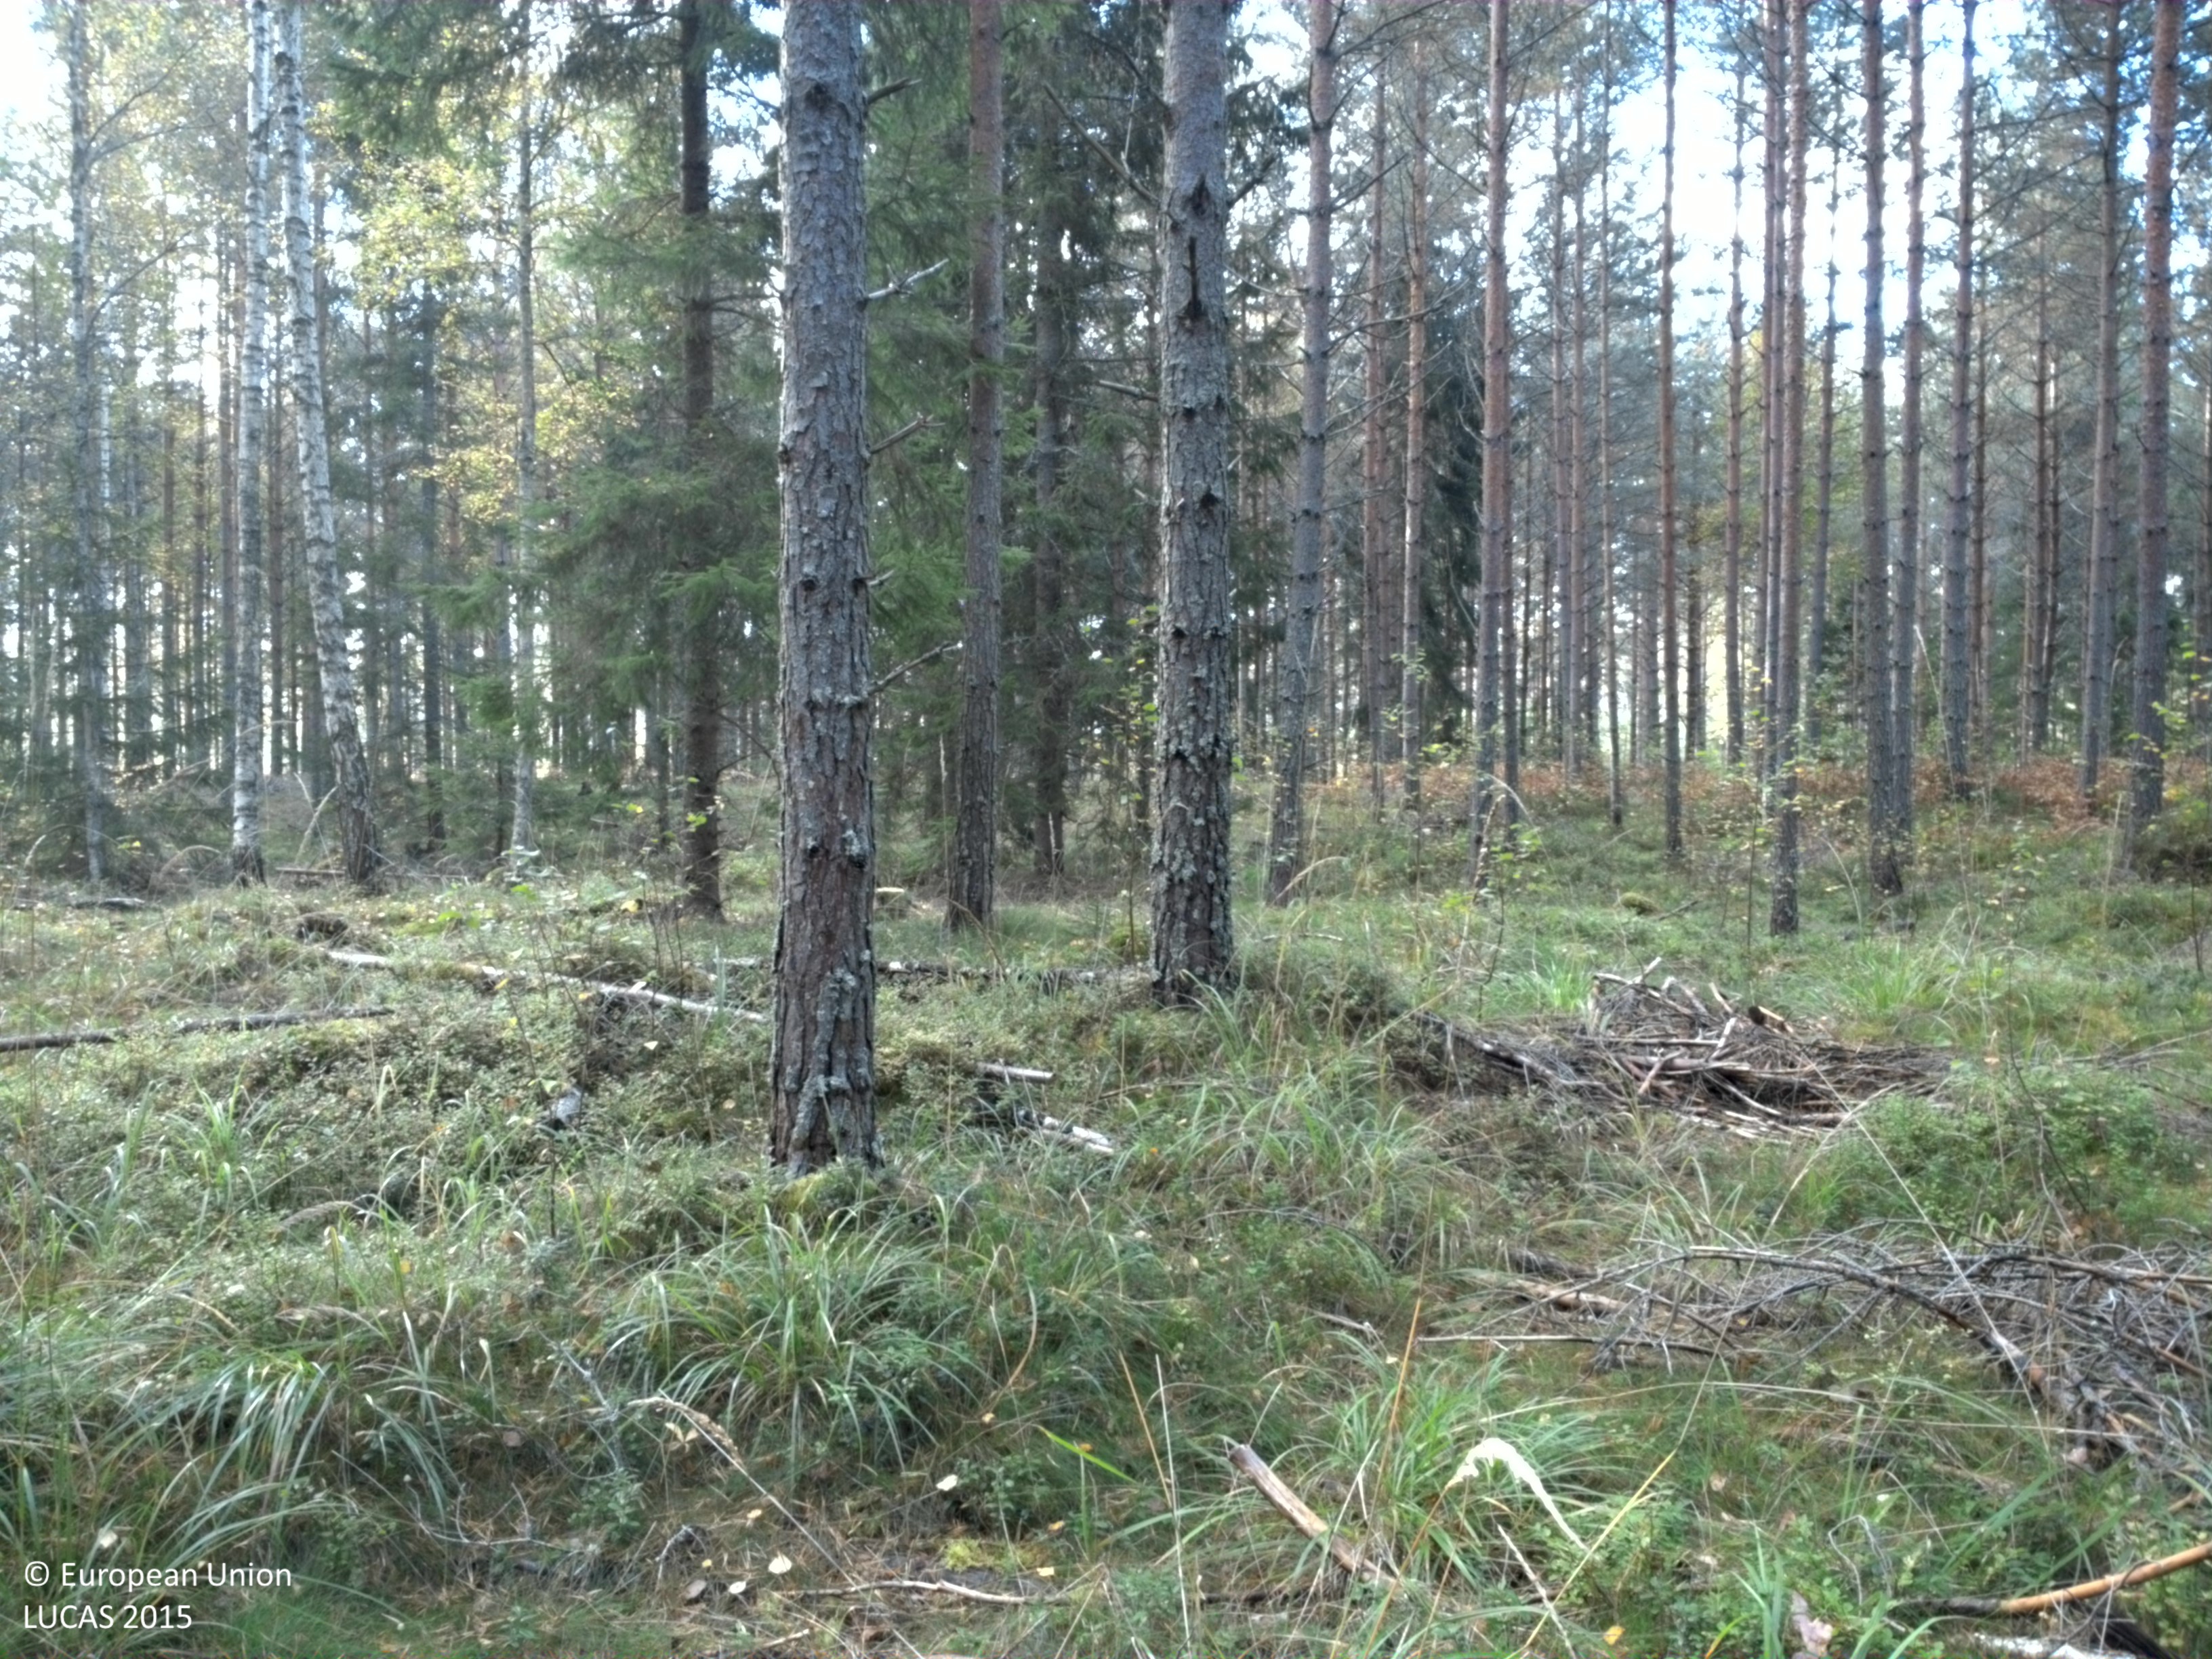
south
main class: Woodland
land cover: Pine dominated coniferous woodland
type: boreal forest
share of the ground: 50 - 75 %
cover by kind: coniferous forest trees 60 %, herbaceous plants 15 %, lichens and mosses 15 %, broadleaved forest trees 10 %
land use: Forestry
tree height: > 5 m
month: September
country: SE
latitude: 60.0127
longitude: 16.5017
